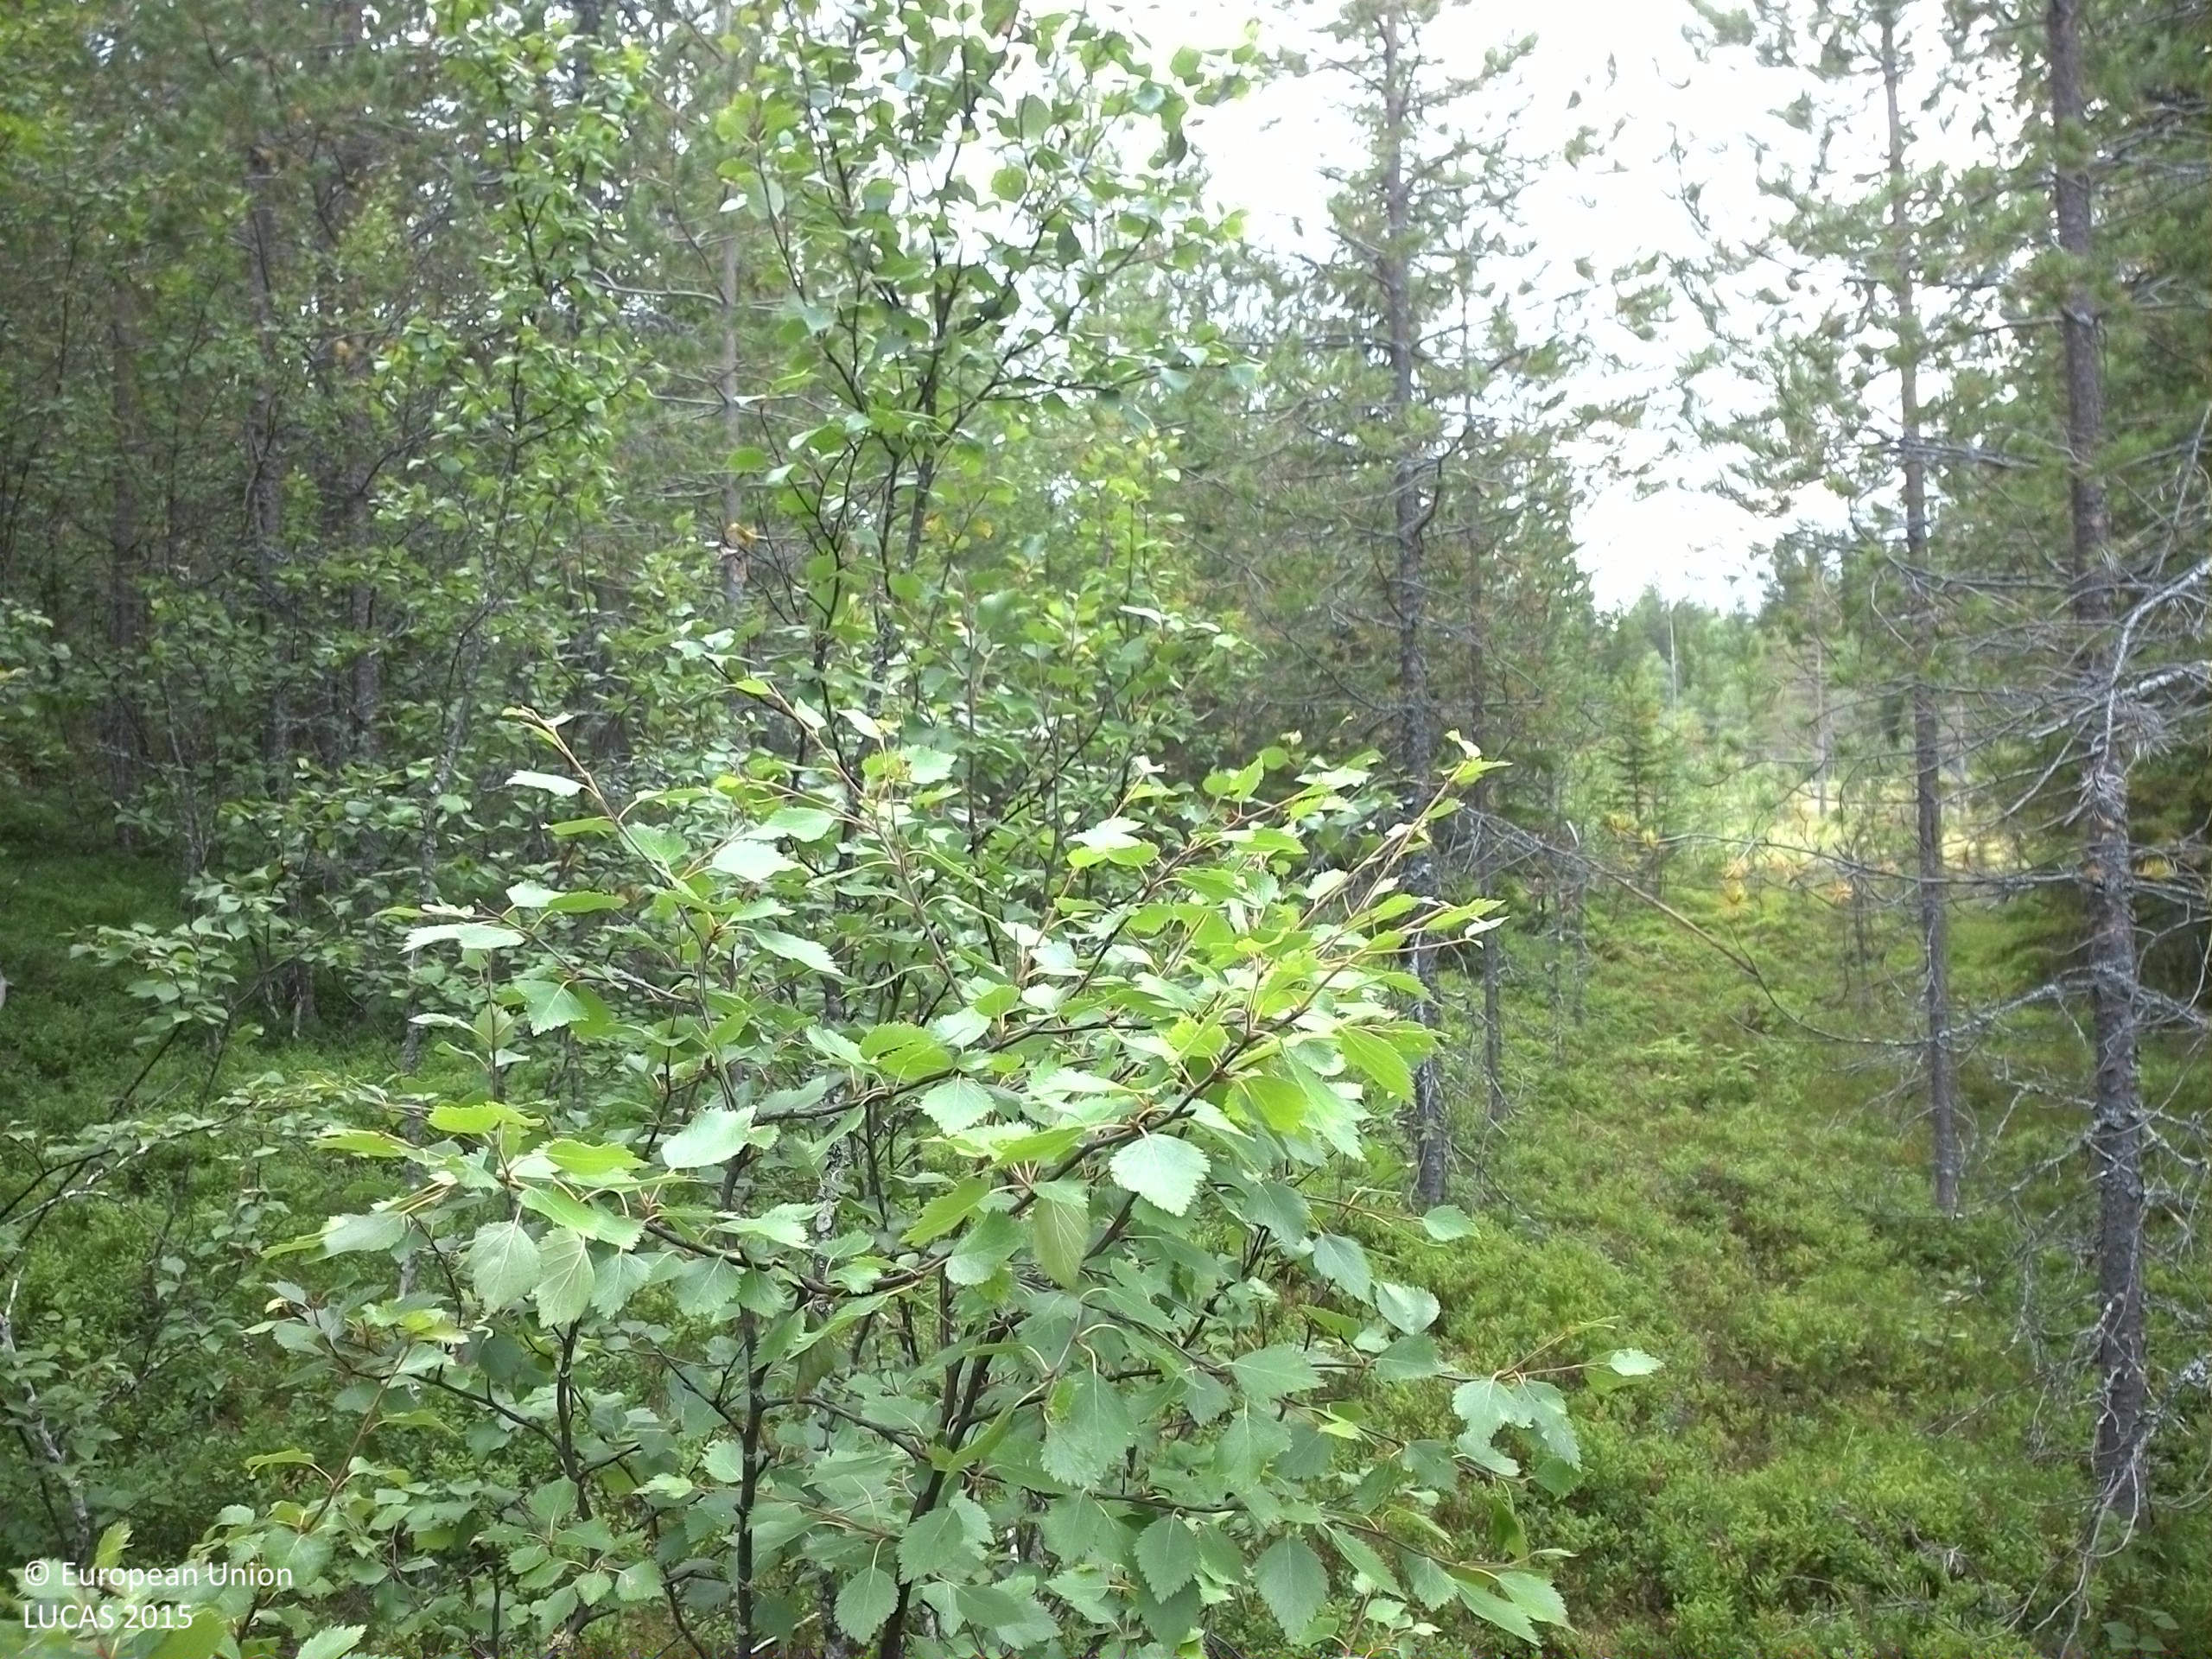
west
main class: Woodland
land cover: Pine dominated mixed woodland
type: boreal forest
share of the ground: 50 - 75 %
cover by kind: coniferous forest trees 45 %, shrubs 30 %, broadleaved forest trees 15 %, herbaceous plants 5 %, lichens and mosses 5 %
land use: Forestry
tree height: < 5 m
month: August
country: SE
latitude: 63.8928
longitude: 17.8949
